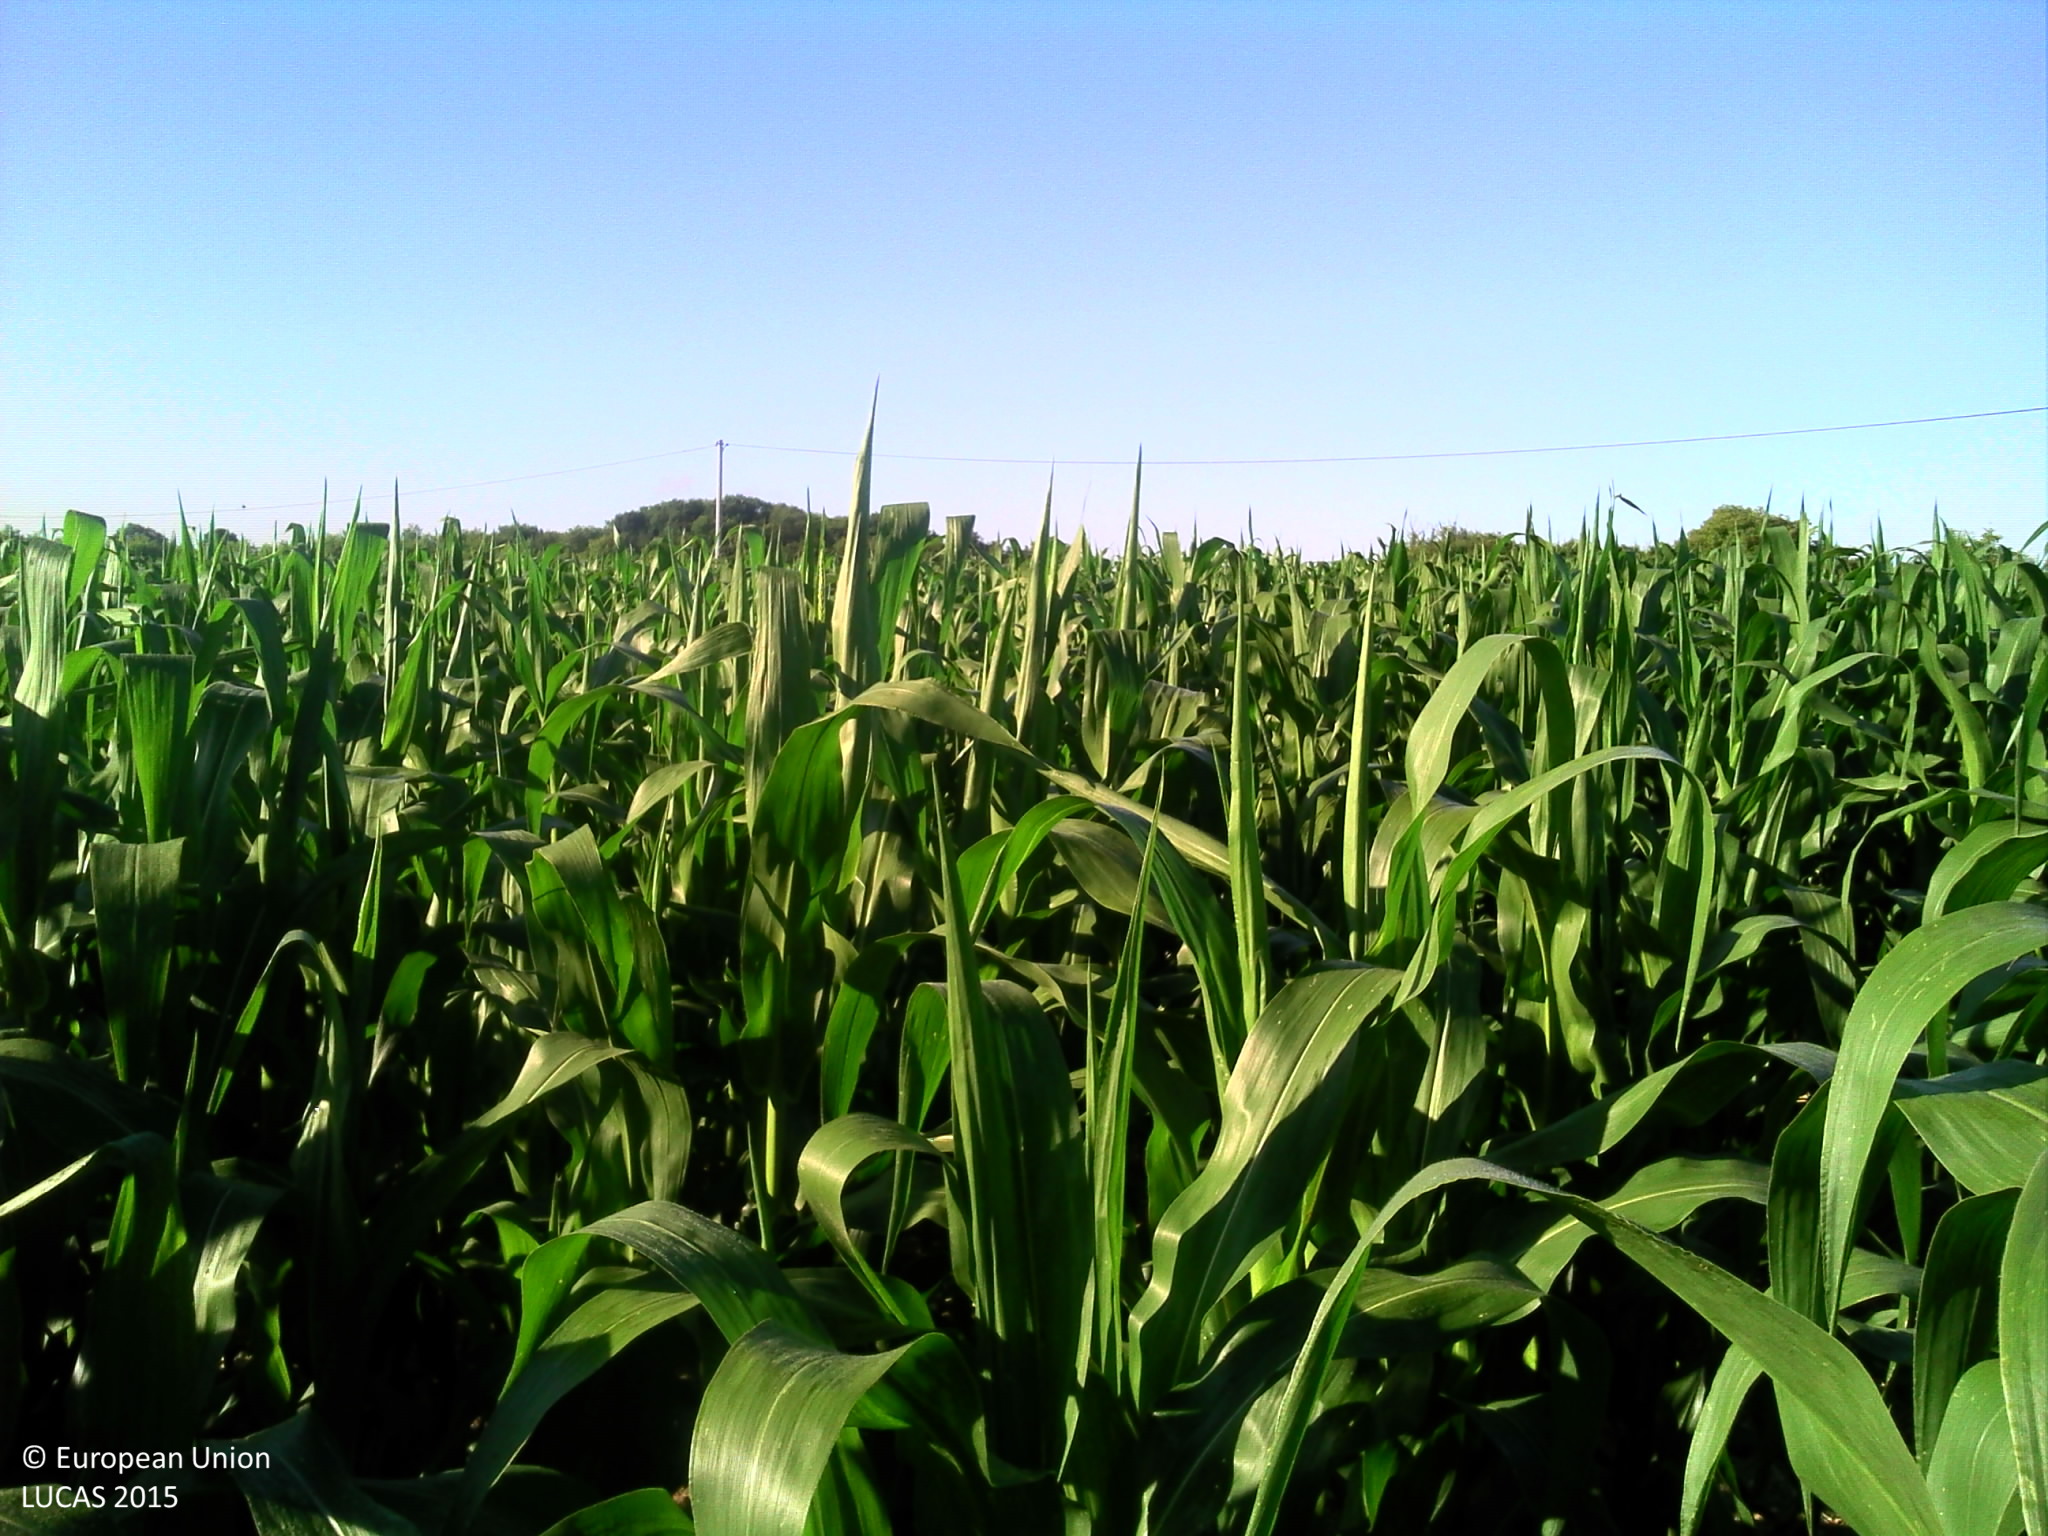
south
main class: Cropland
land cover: Maize
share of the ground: > 75 %
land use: Agriculture (excluding fallow land and kitchen gardens)
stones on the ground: 25 - 50 %
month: June
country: FR
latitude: 45.6325
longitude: -0.8654
